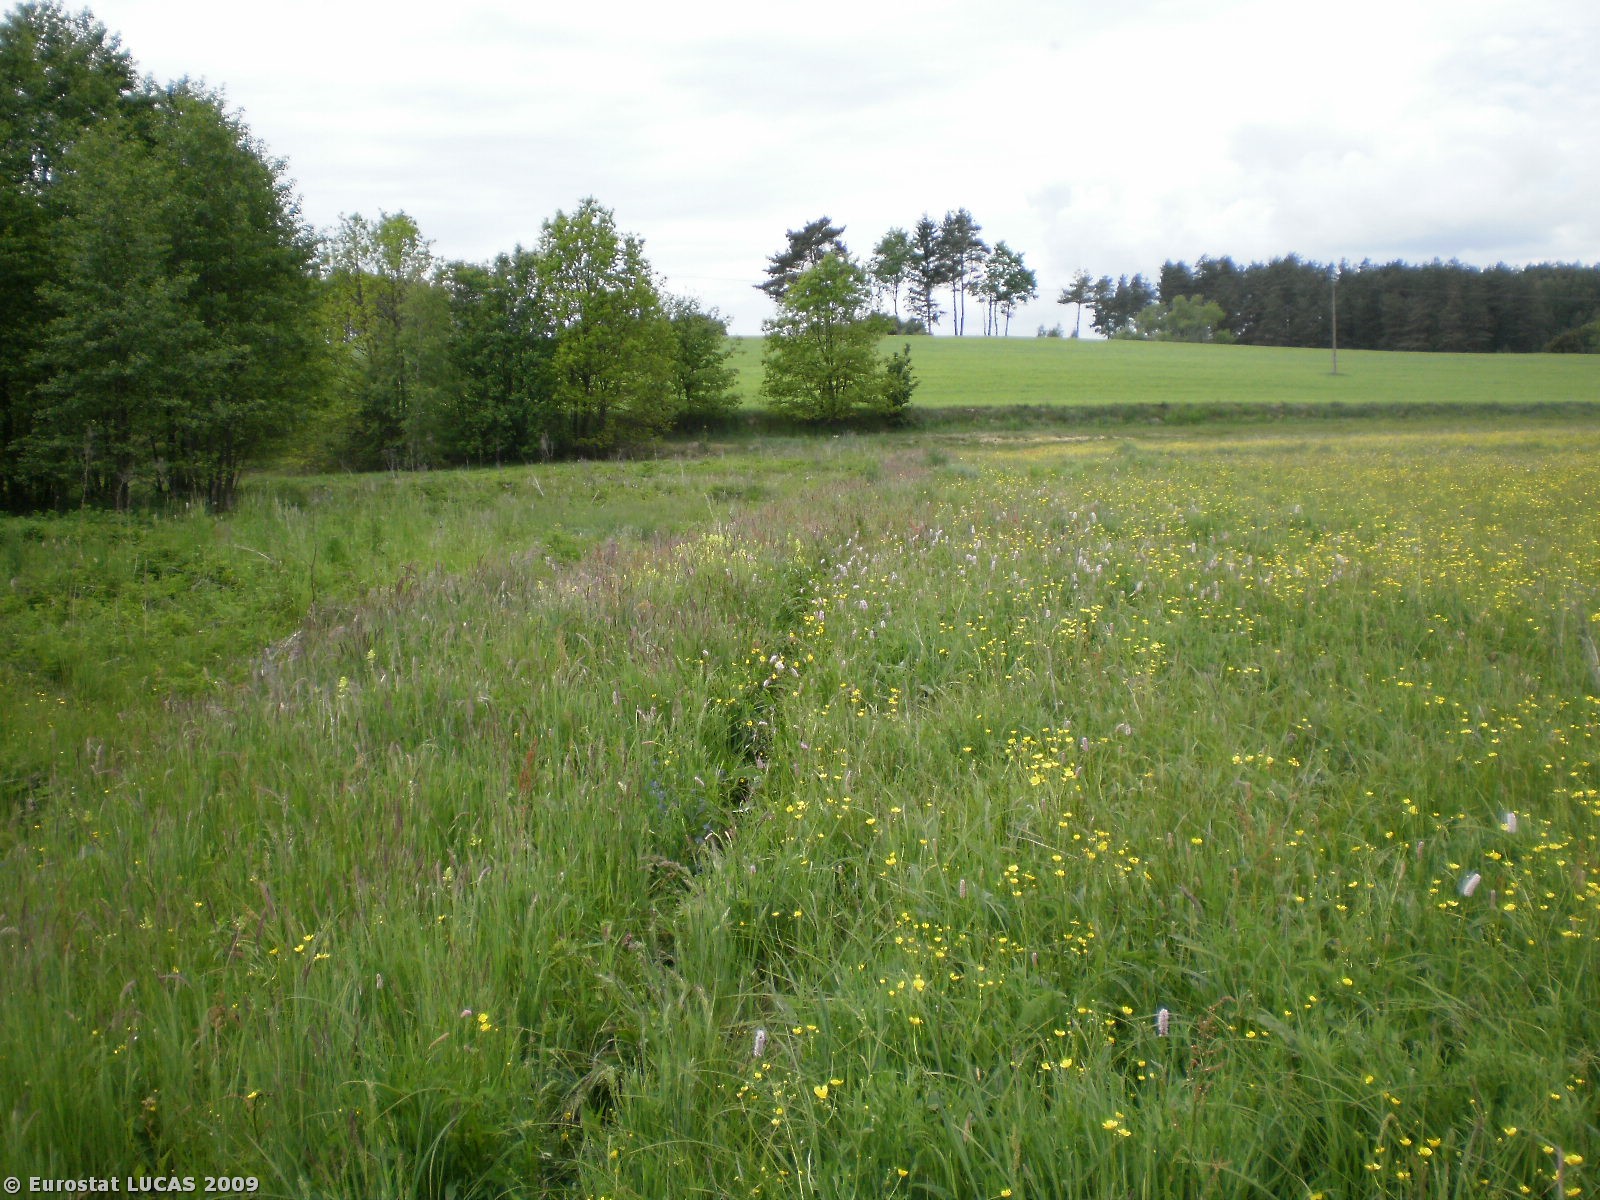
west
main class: Grassland
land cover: Grassland without tree/shrub cover
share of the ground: > 75 %
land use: Agriculture (excluding fallow land and kitchen gardens)
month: June
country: PL
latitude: 54.3932
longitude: 17.8519
